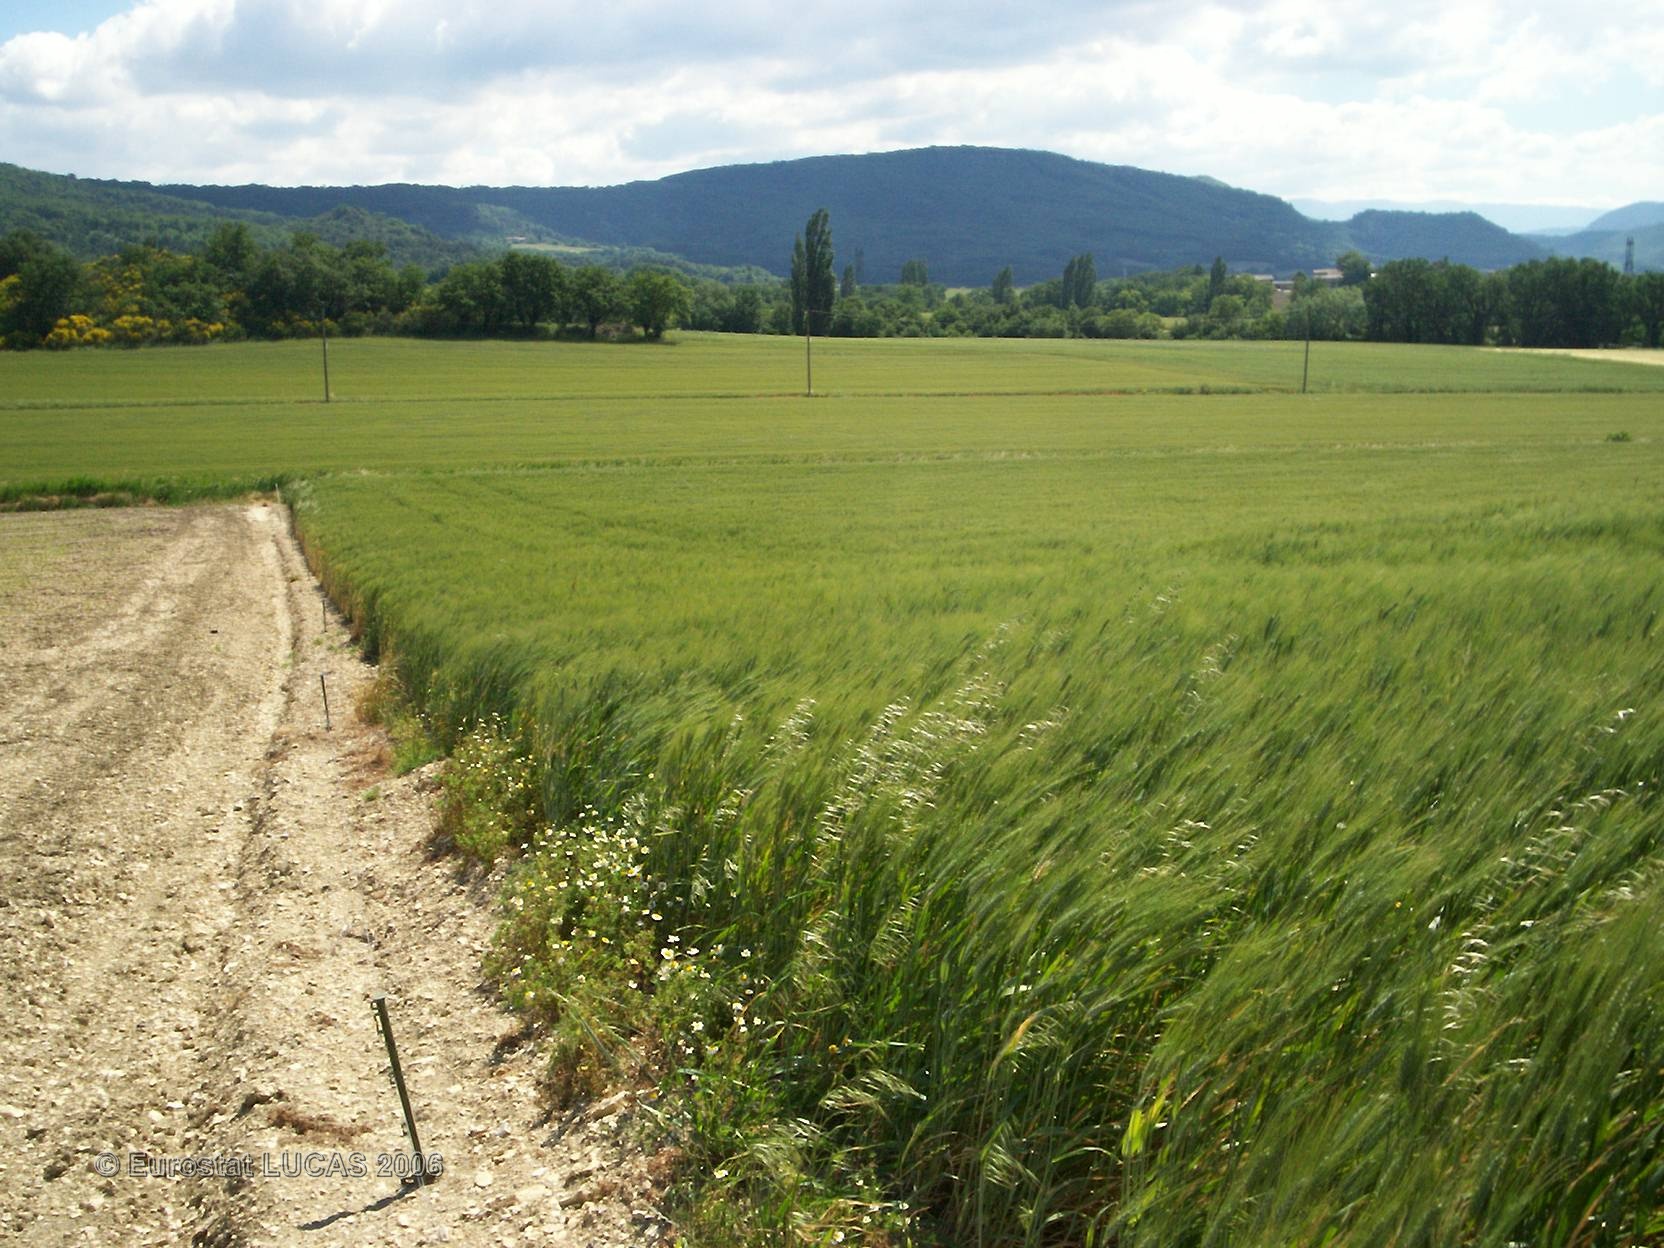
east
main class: Cropland
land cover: Maize
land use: Agriculture (excluding fallow land and kitchen gardens)
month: May
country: FR
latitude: 44.6587
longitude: 4.8989
